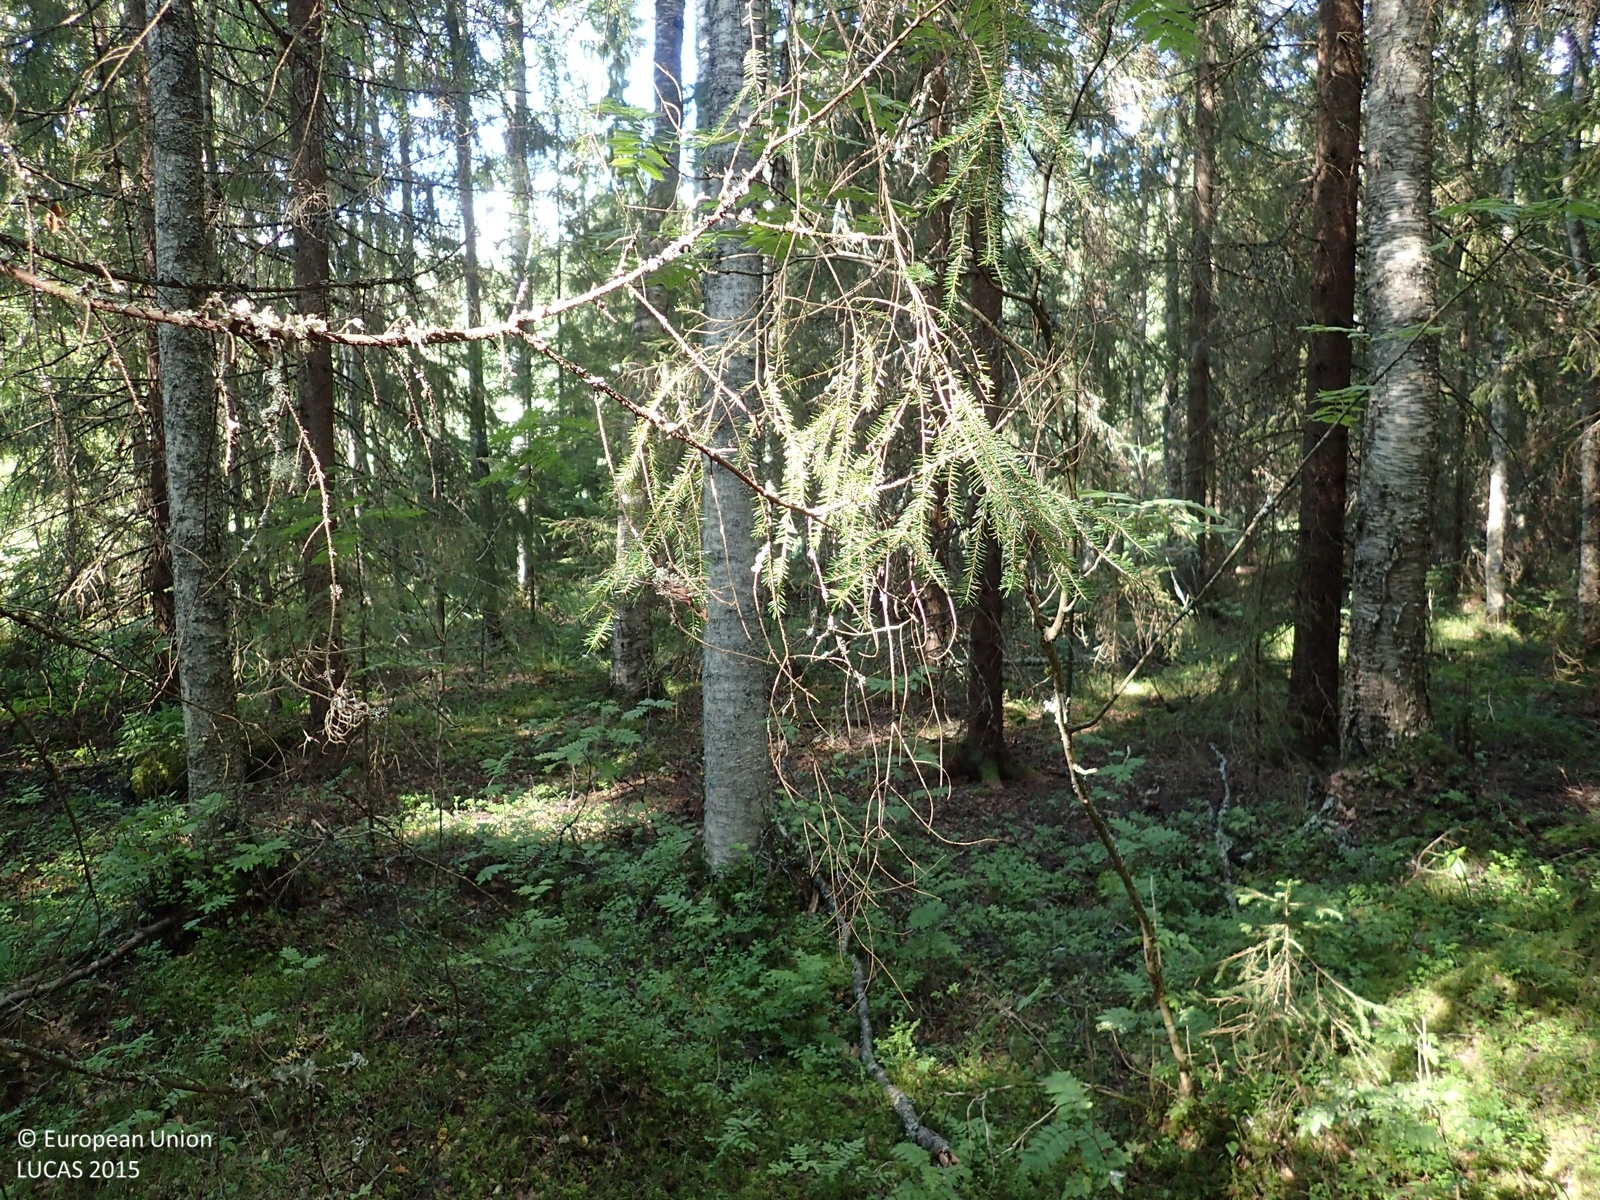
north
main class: Woodland
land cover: Spruce dominated coniferous woodland
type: boreal forest
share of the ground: > 75 %
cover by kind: coniferous forest trees 70 %, broadleaved forest trees 15 %, herbaceous plants 10 %, lichens and mosses 5 %
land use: Forestry
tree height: > 5 m
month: August
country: FI
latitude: 62.7452
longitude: 22.0859
